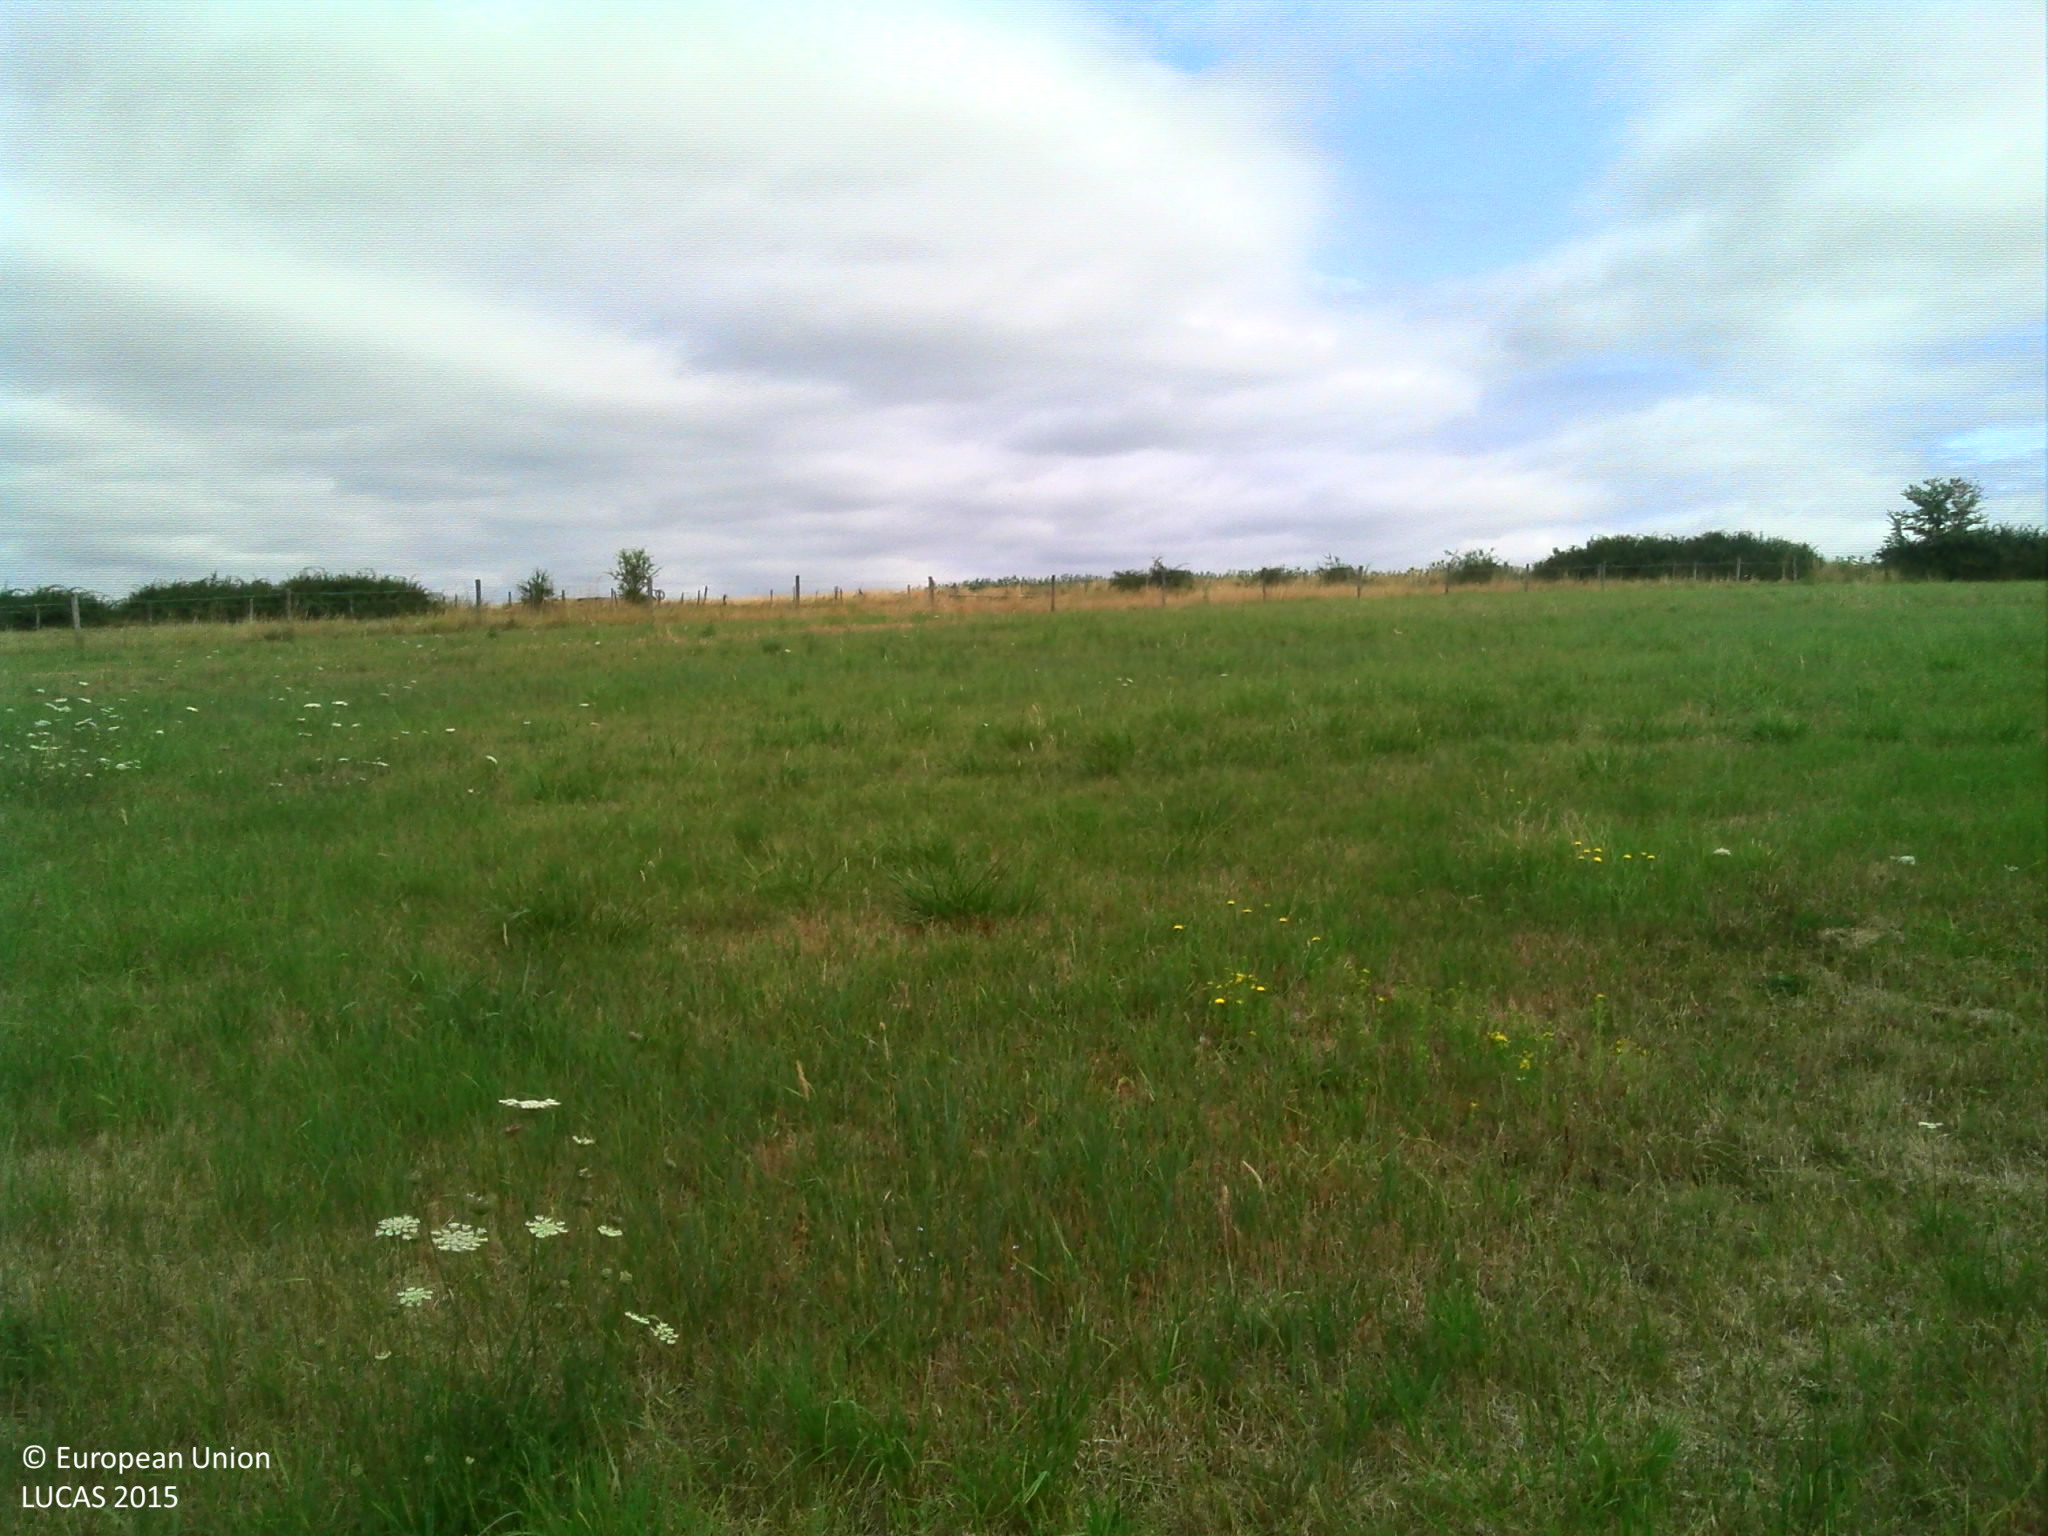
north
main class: Grassland
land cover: Grassland without tree/shrub cover
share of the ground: > 75 %
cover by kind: herbaceous plants 100 %
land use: Agriculture (excluding fallow land and kitchen gardens)
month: July
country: FR
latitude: 47.2311
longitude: 0.4828
